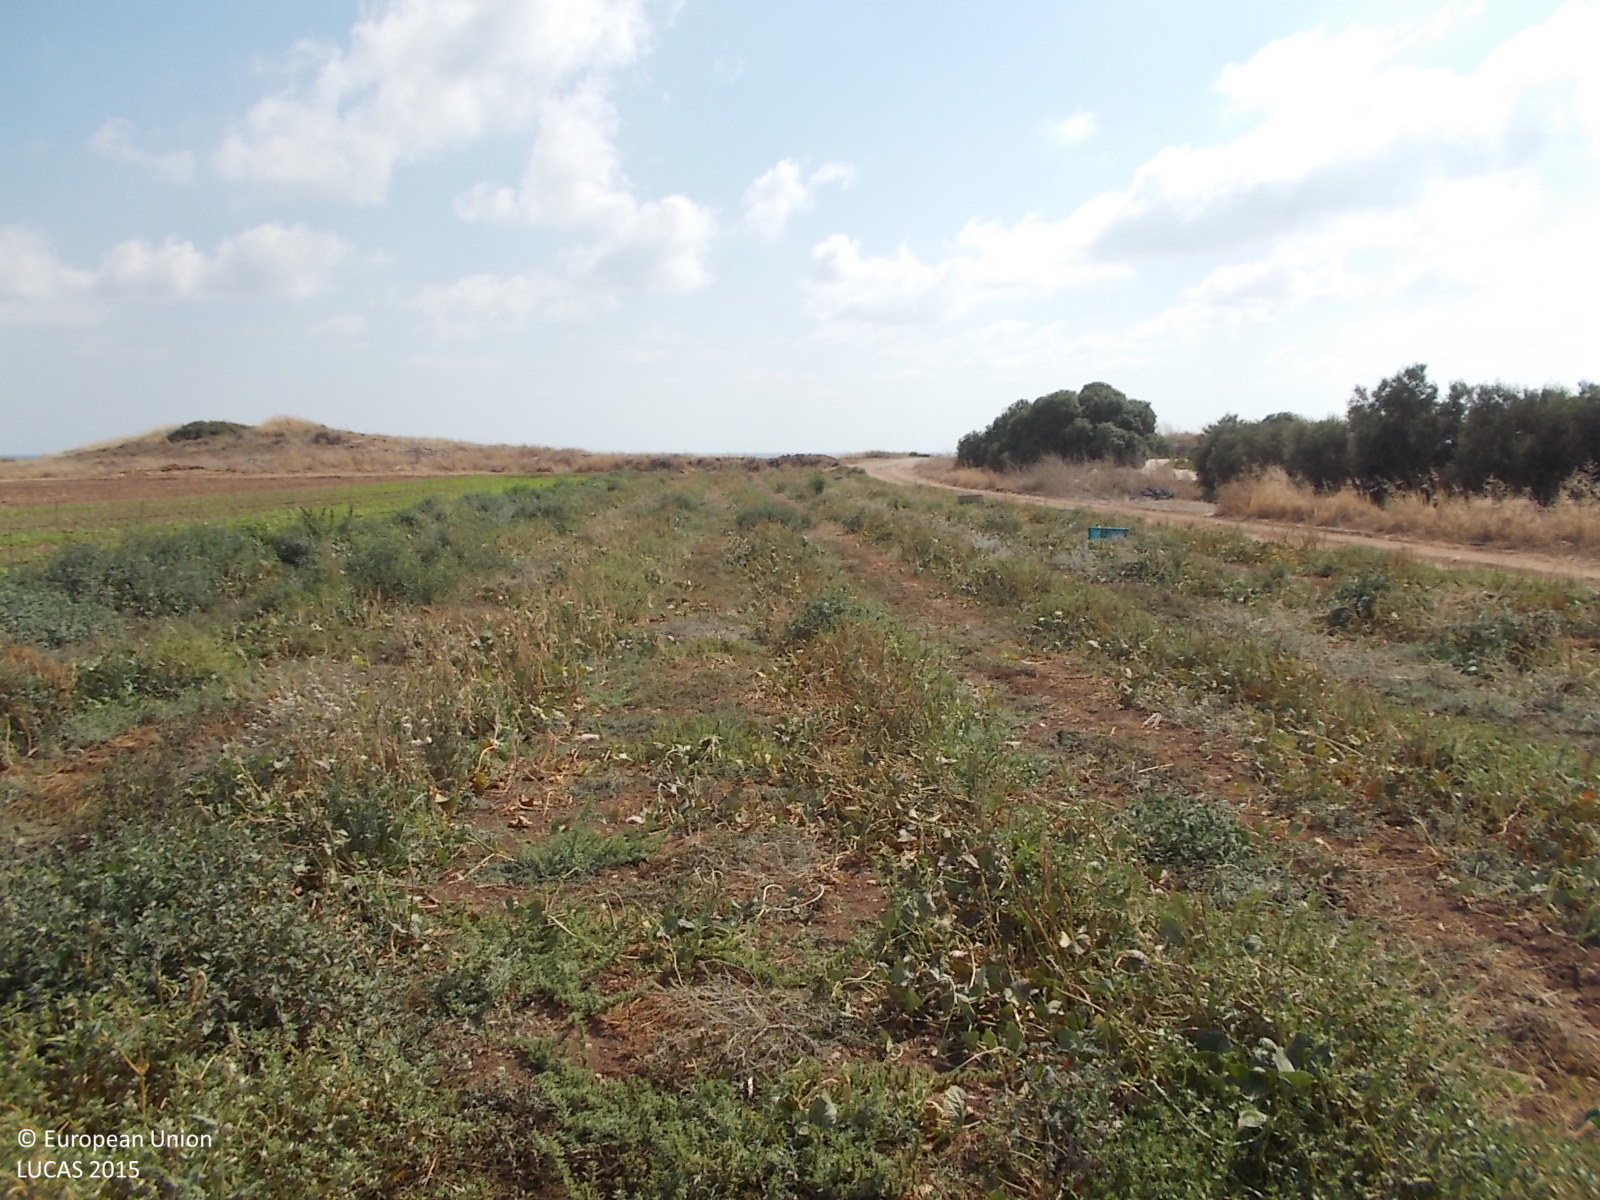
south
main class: Cropland
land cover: Dry pulses
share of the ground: 25 - 50 %
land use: Agriculture (excluding fallow land and kitchen gardens)
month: May
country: CY
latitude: 34.7099
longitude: 32.5177
